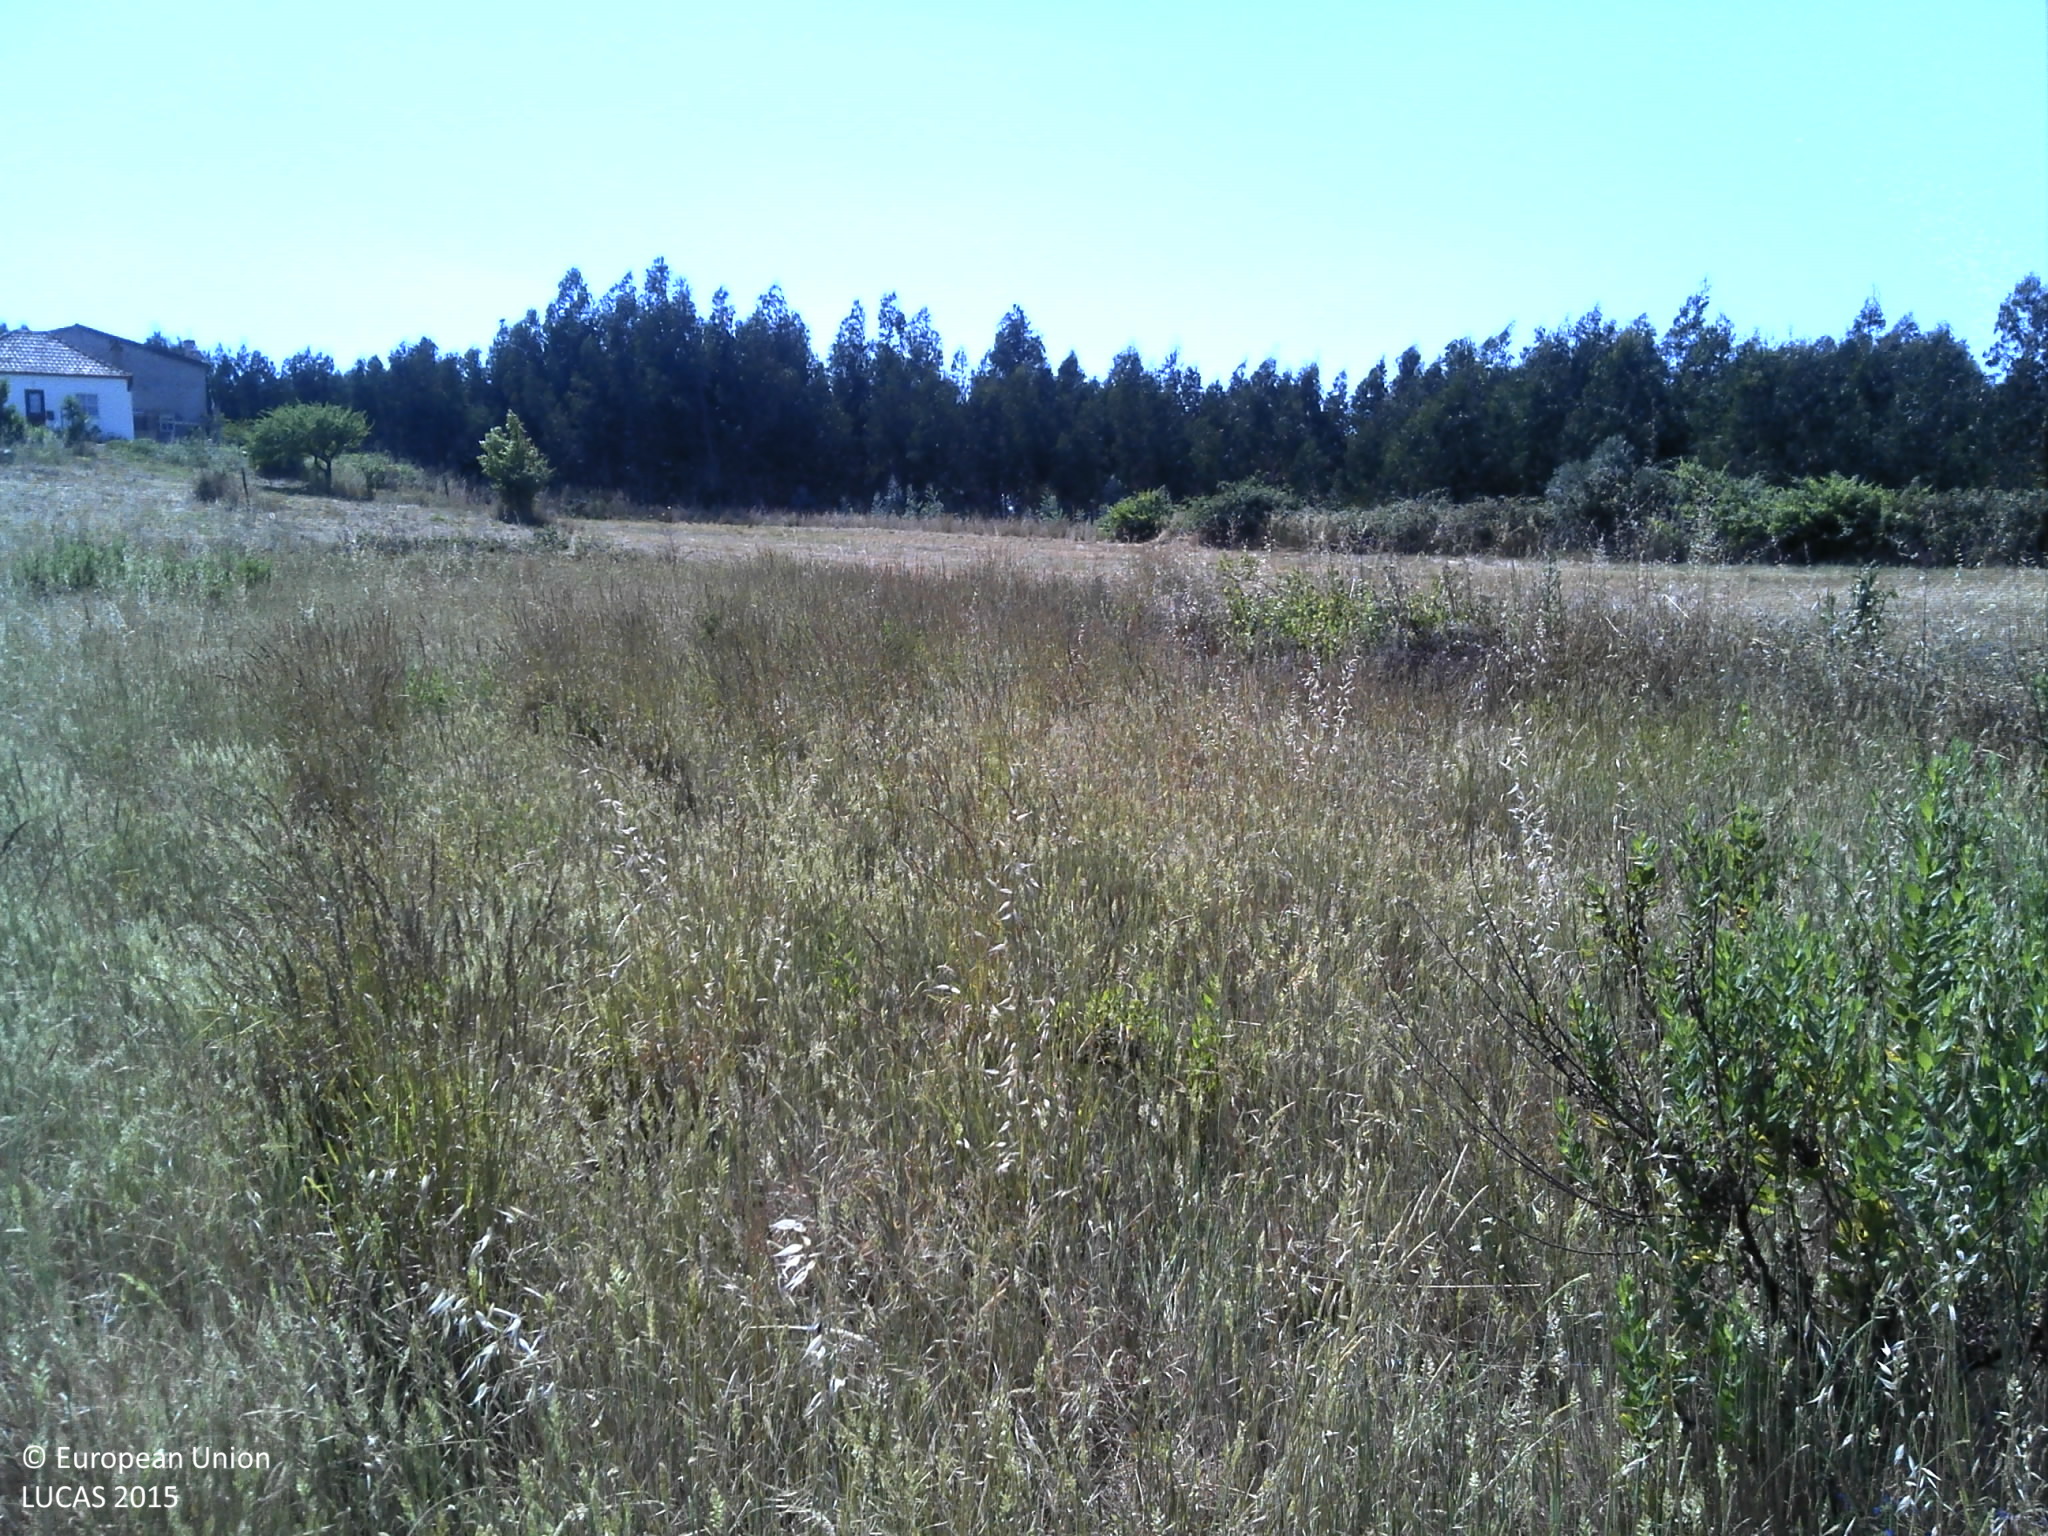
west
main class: Grassland
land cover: Spontaneously vegetated surfaces
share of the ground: > 75 %
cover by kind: herbaceous plants 80 %, unconsolidated bare surface 20 %
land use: Fallow land
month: June
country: PT
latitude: 39.1712
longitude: -9.2673
